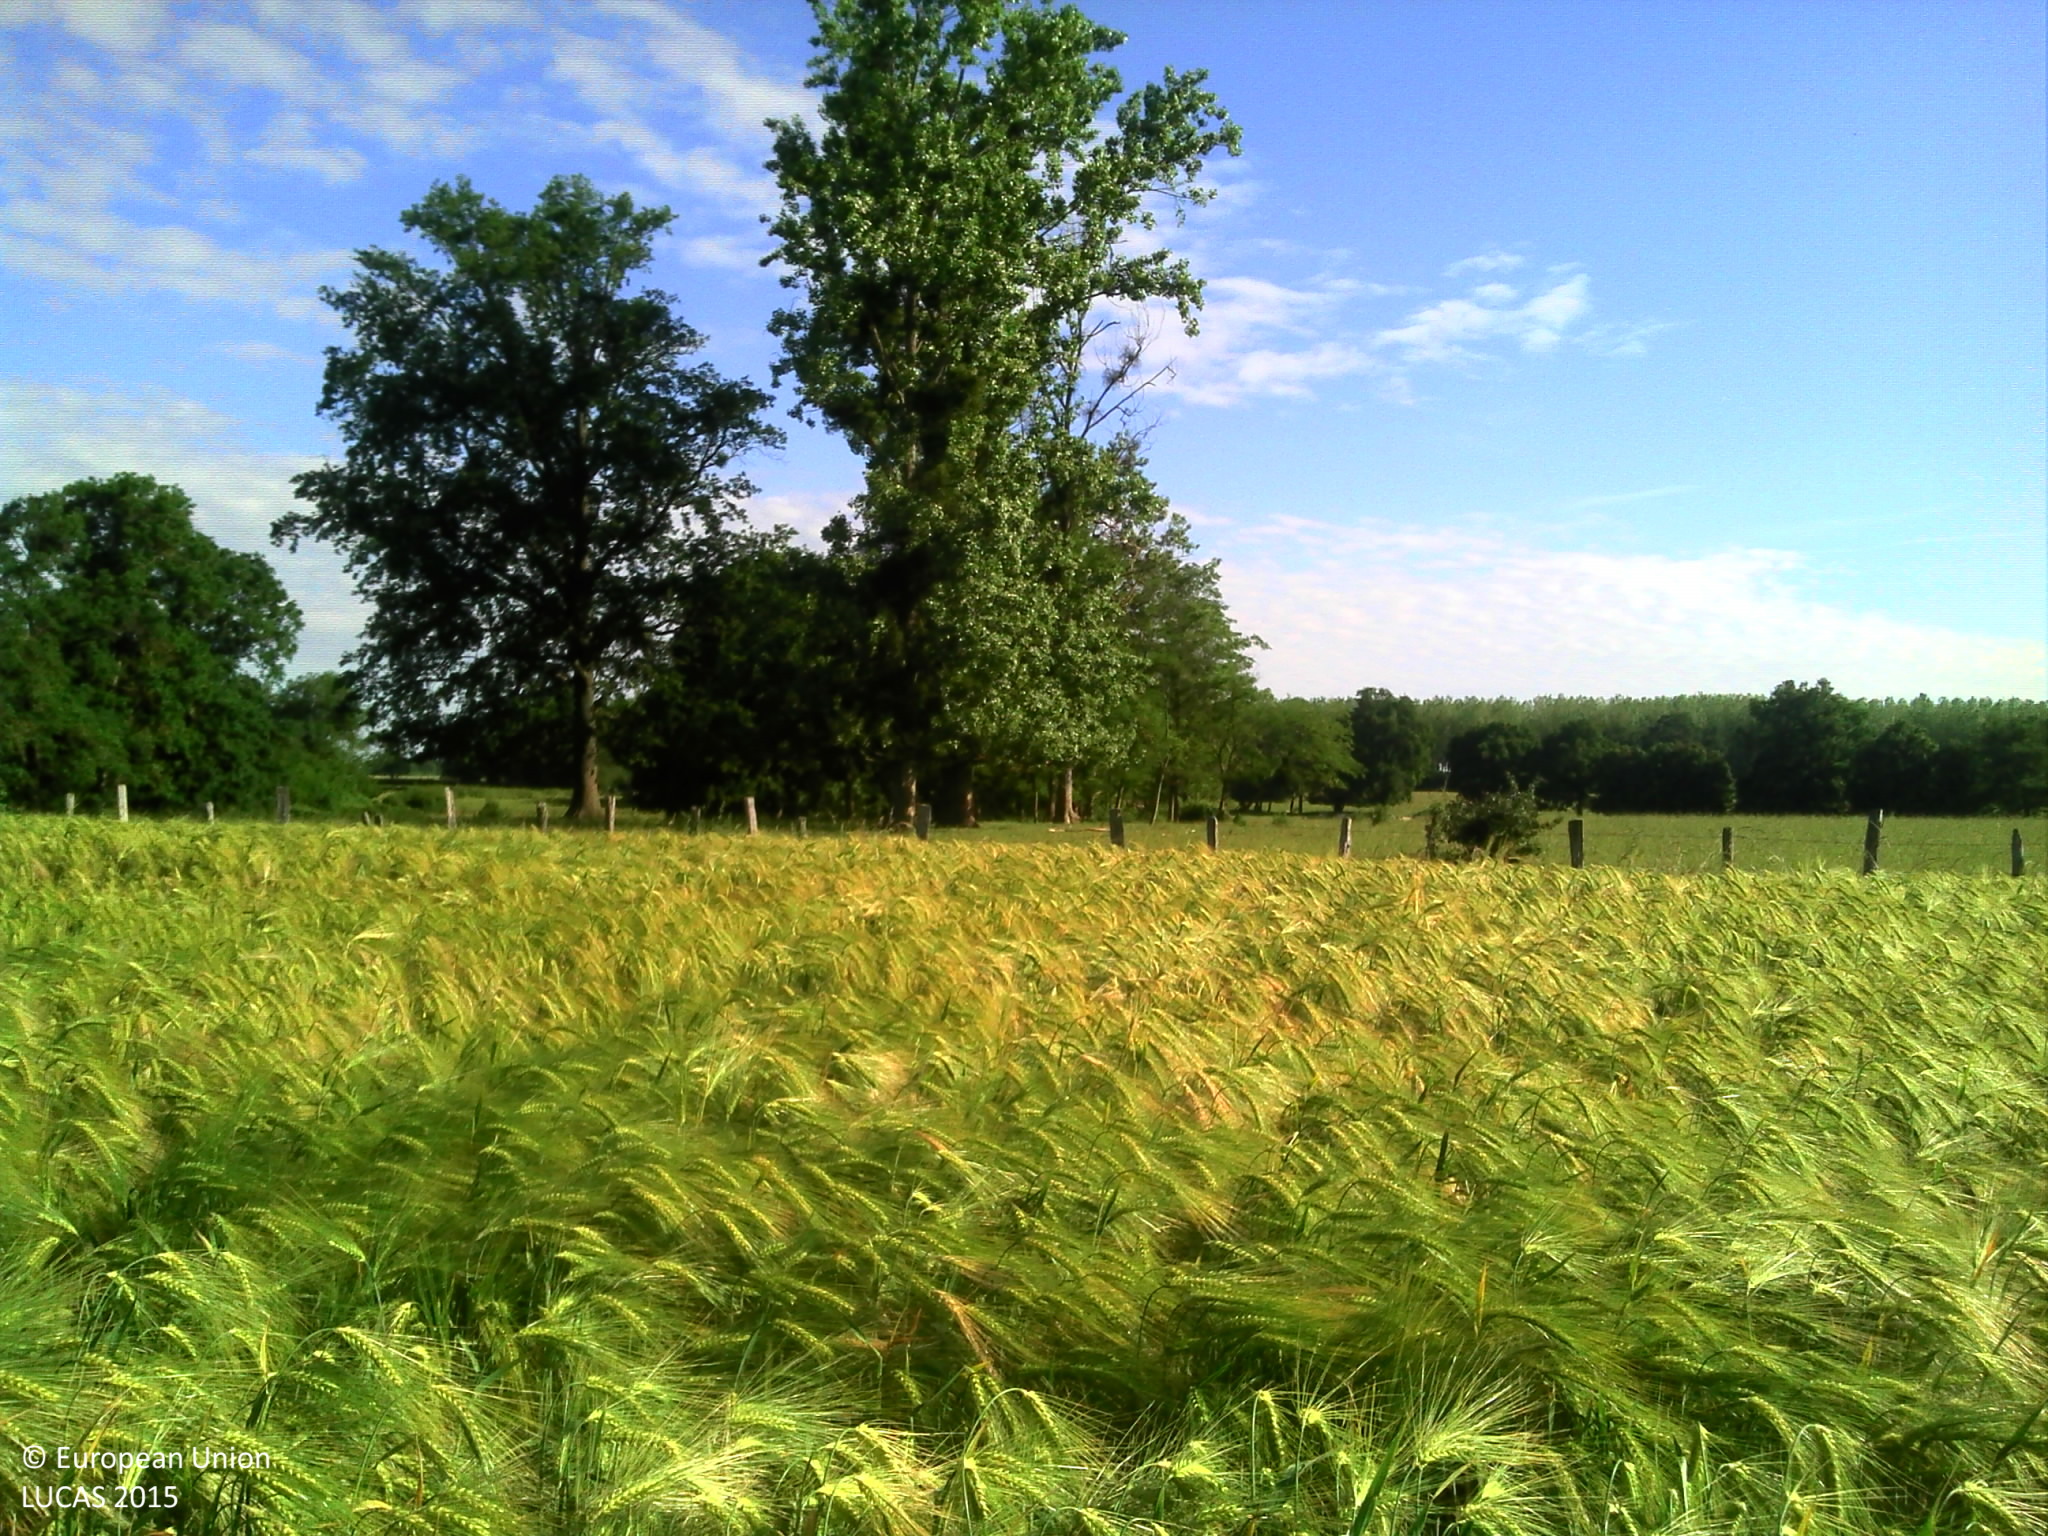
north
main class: Cropland
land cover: Barley
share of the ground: > 75 %
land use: Agriculture (excluding fallow land and kitchen gardens)
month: June
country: FR
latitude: 46.6263
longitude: 4.8950
